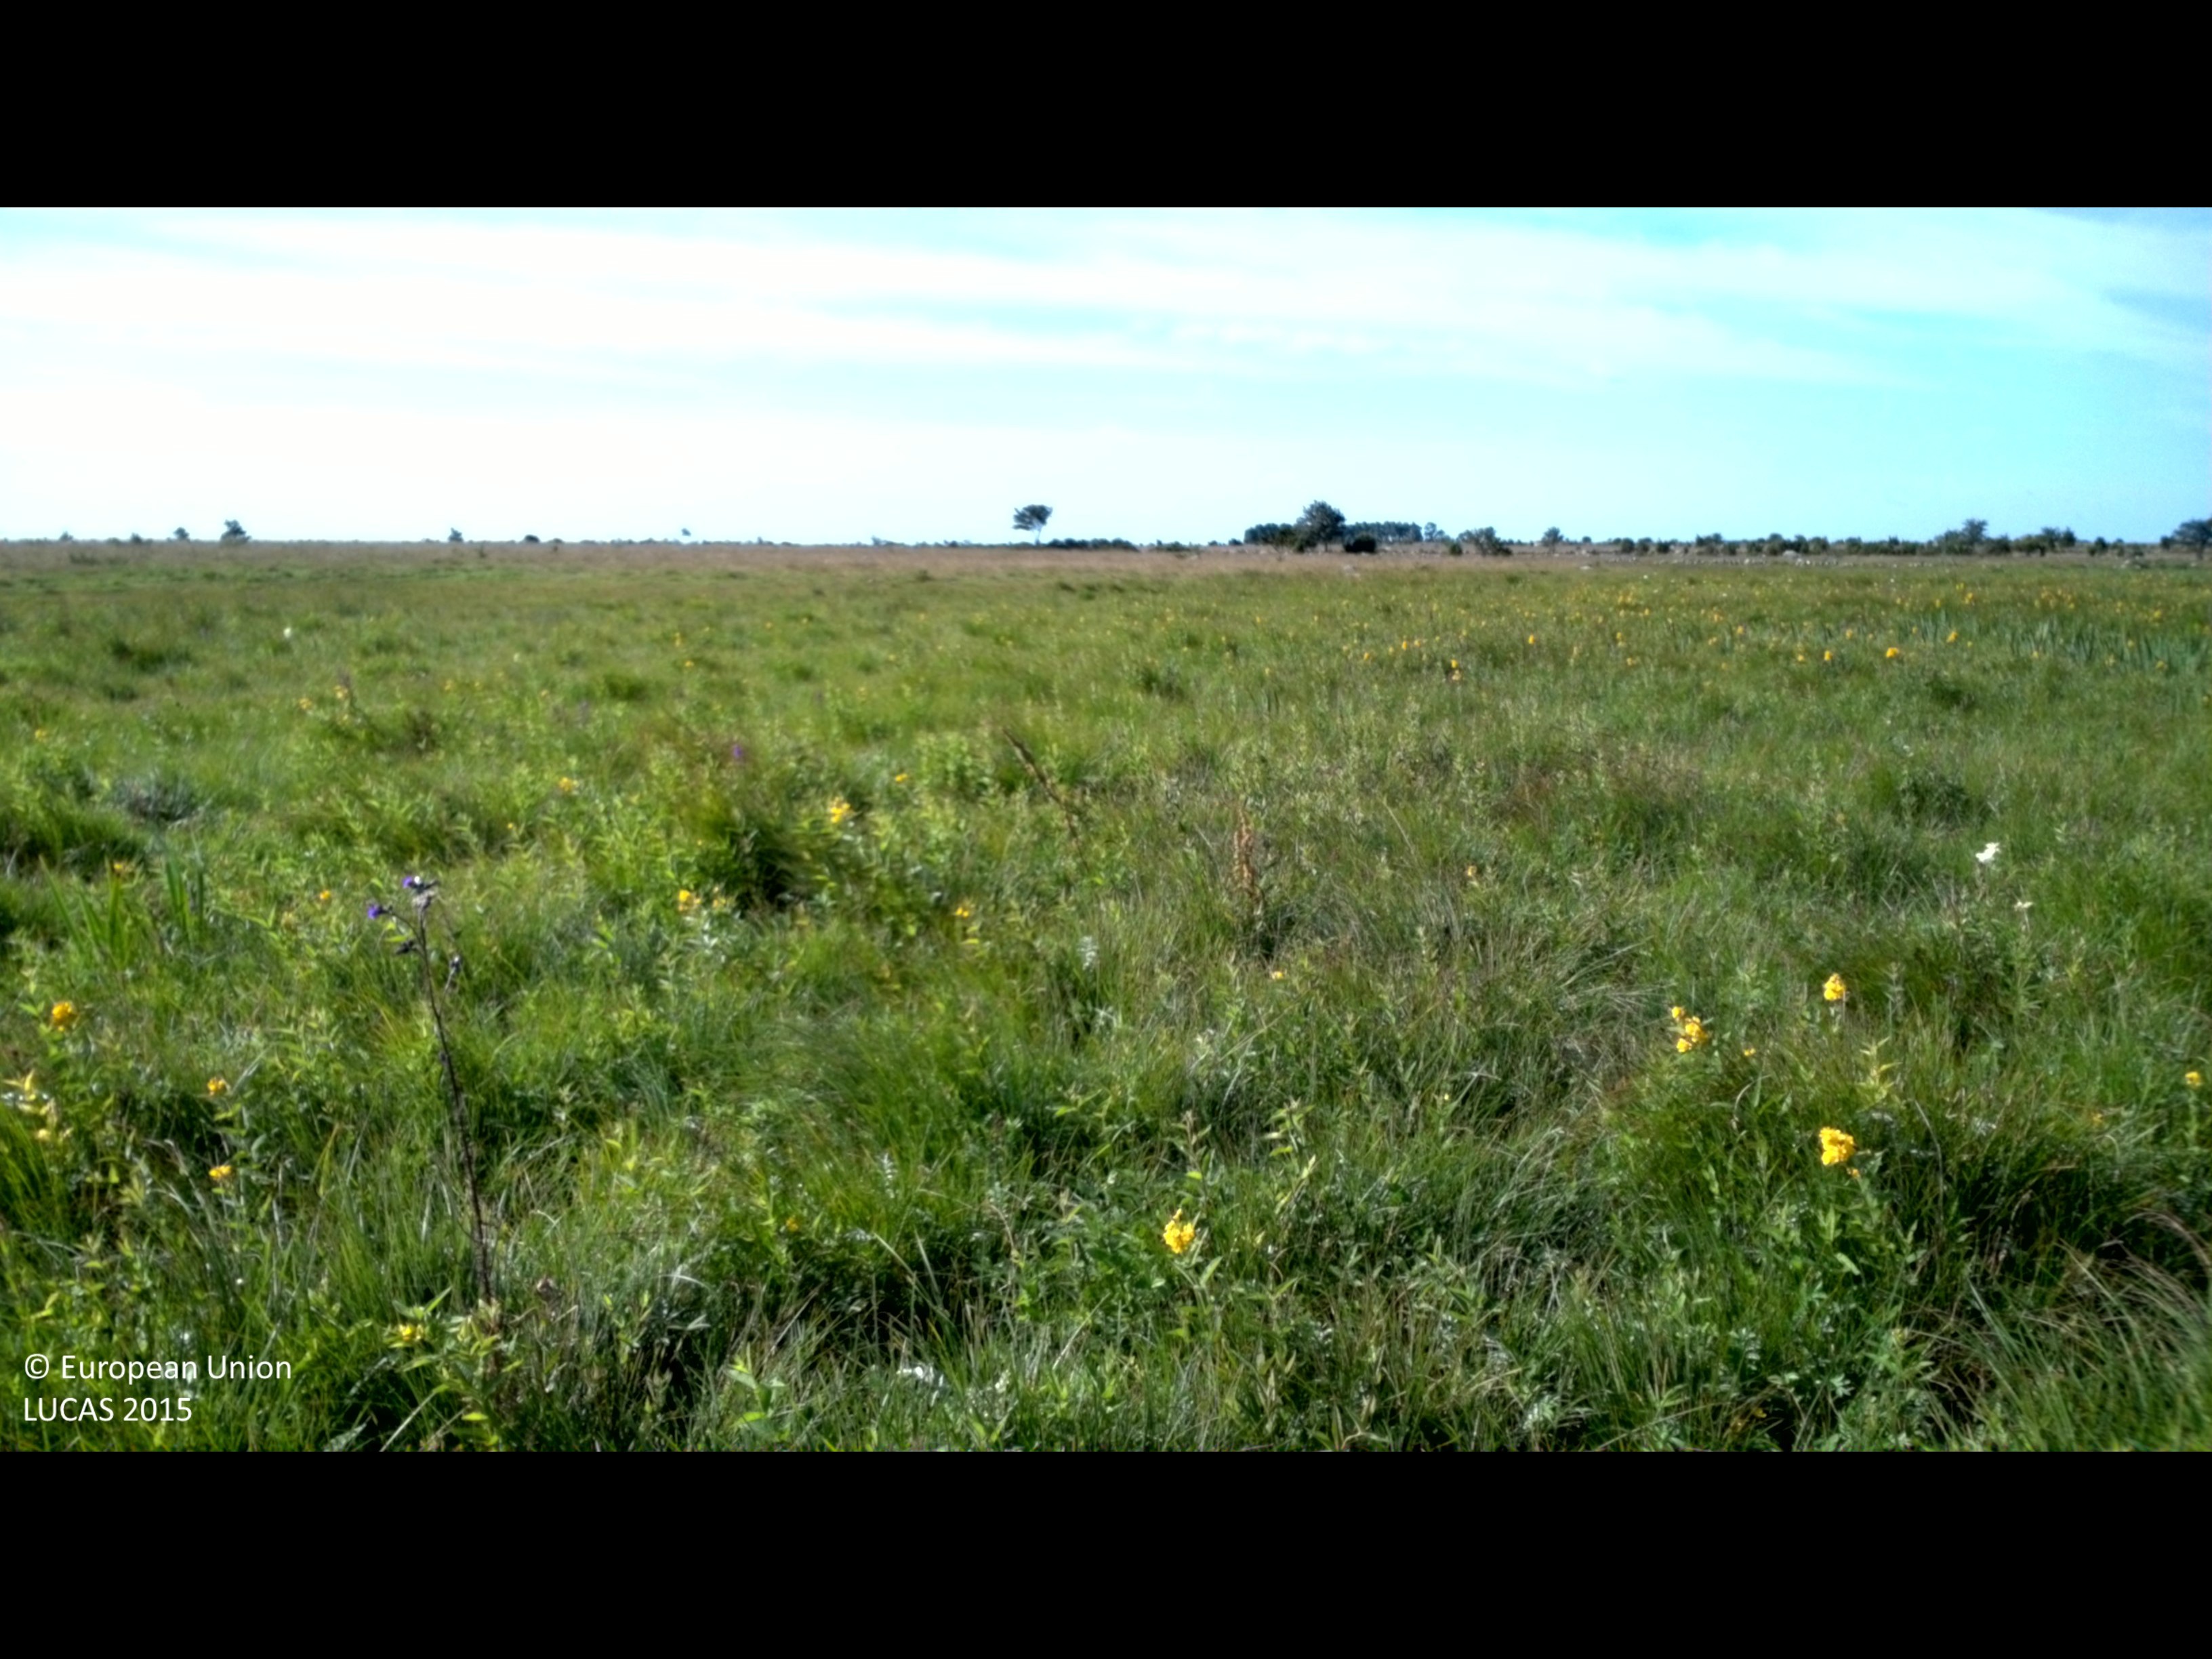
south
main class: Grassland
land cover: Grassland without tree/shrub cover
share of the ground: > 75 %
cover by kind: herbaceous plants 100 %
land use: Agriculture (excluding fallow land and kitchen gardens)
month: July
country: SE
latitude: 56.9235
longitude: 16.8859
